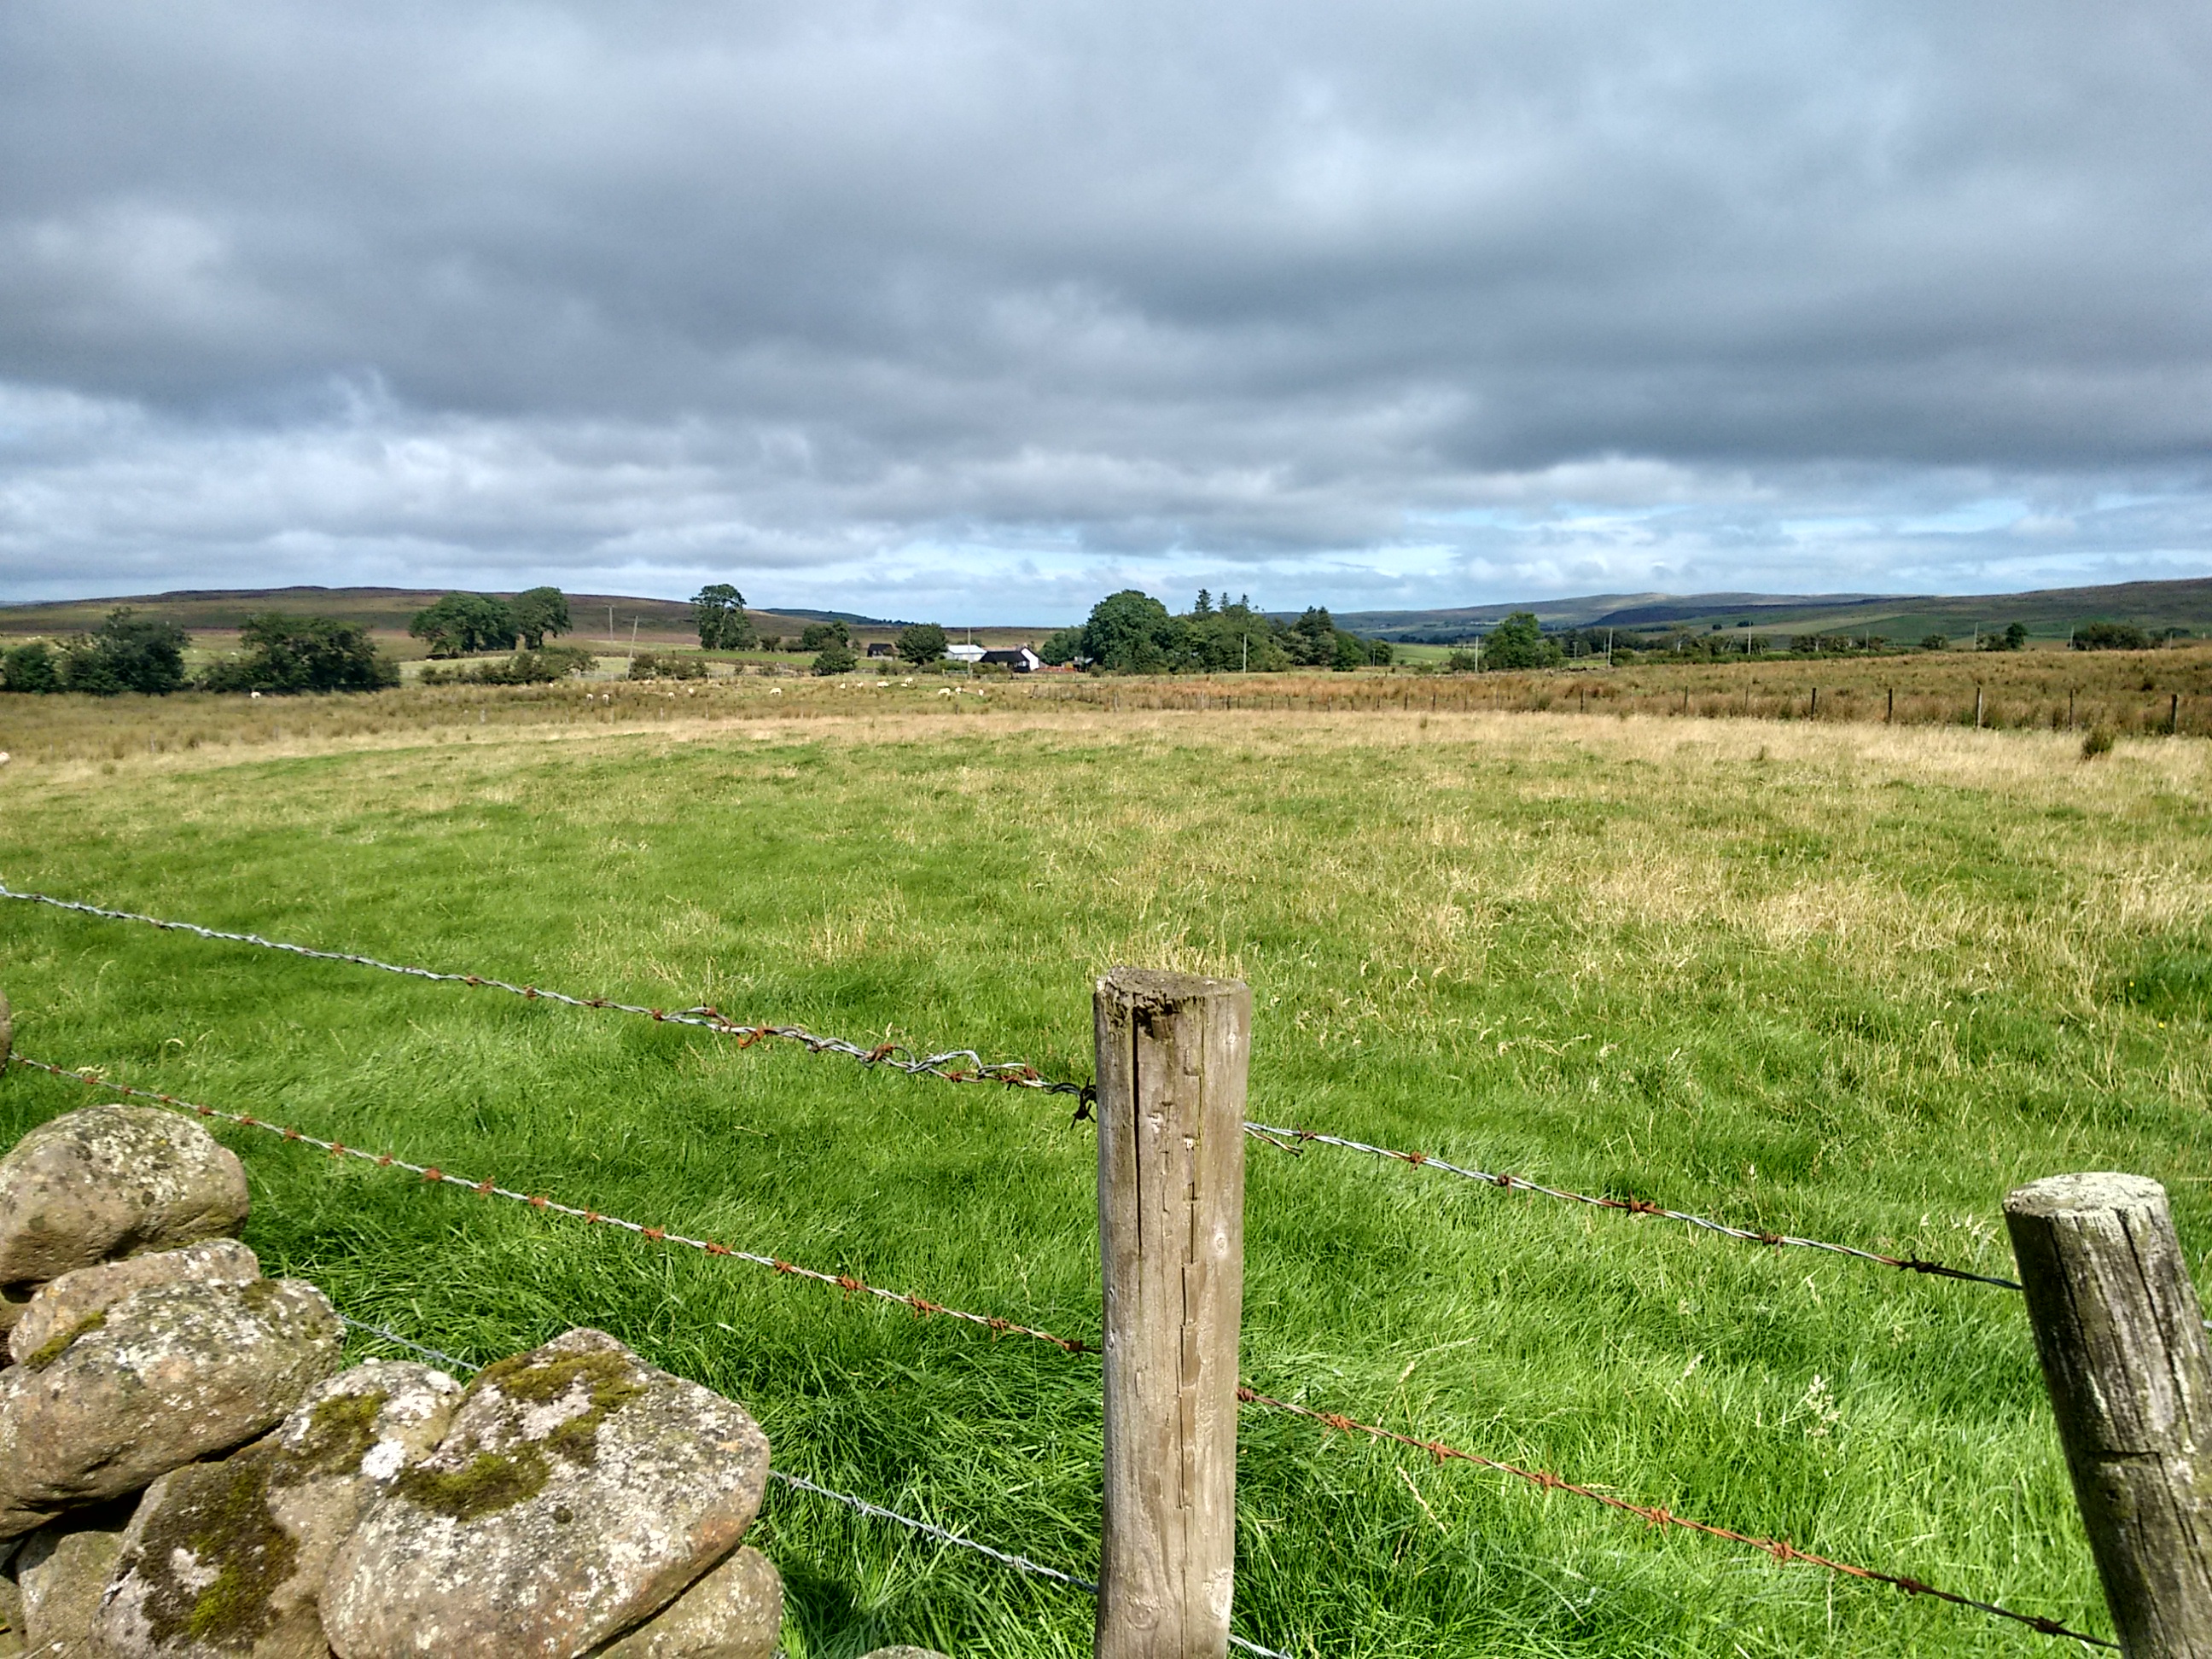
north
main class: Grassland
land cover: Grassland without tree/shrub cover
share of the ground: > 75 %
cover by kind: herbaceous plants 100 %
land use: Agriculture (excluding fallow land and kitchen gardens)
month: September
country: GB
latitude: 54.8732
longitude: -6.0524
